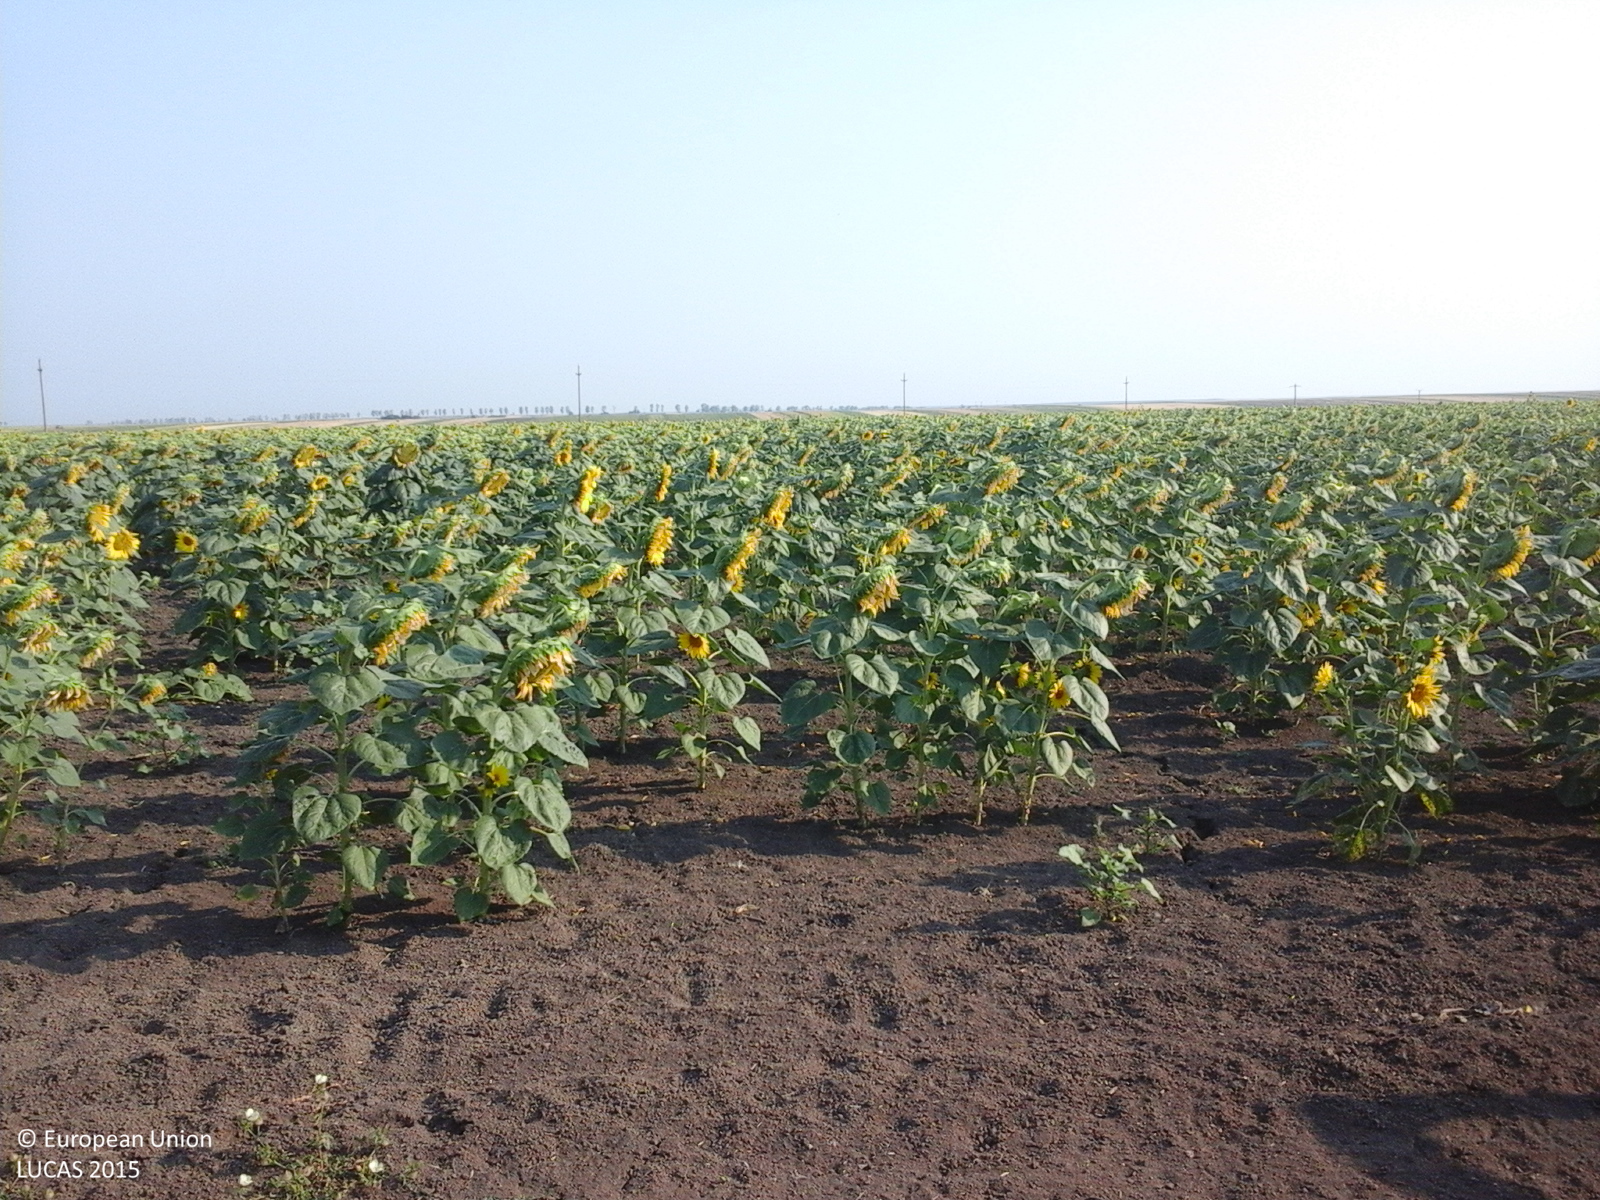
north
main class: Cropland
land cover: Sunflower
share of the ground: > 75 %
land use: Agriculture (excluding fallow land and kitchen gardens)
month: August
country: RO
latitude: 44.4244
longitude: 23.2756
